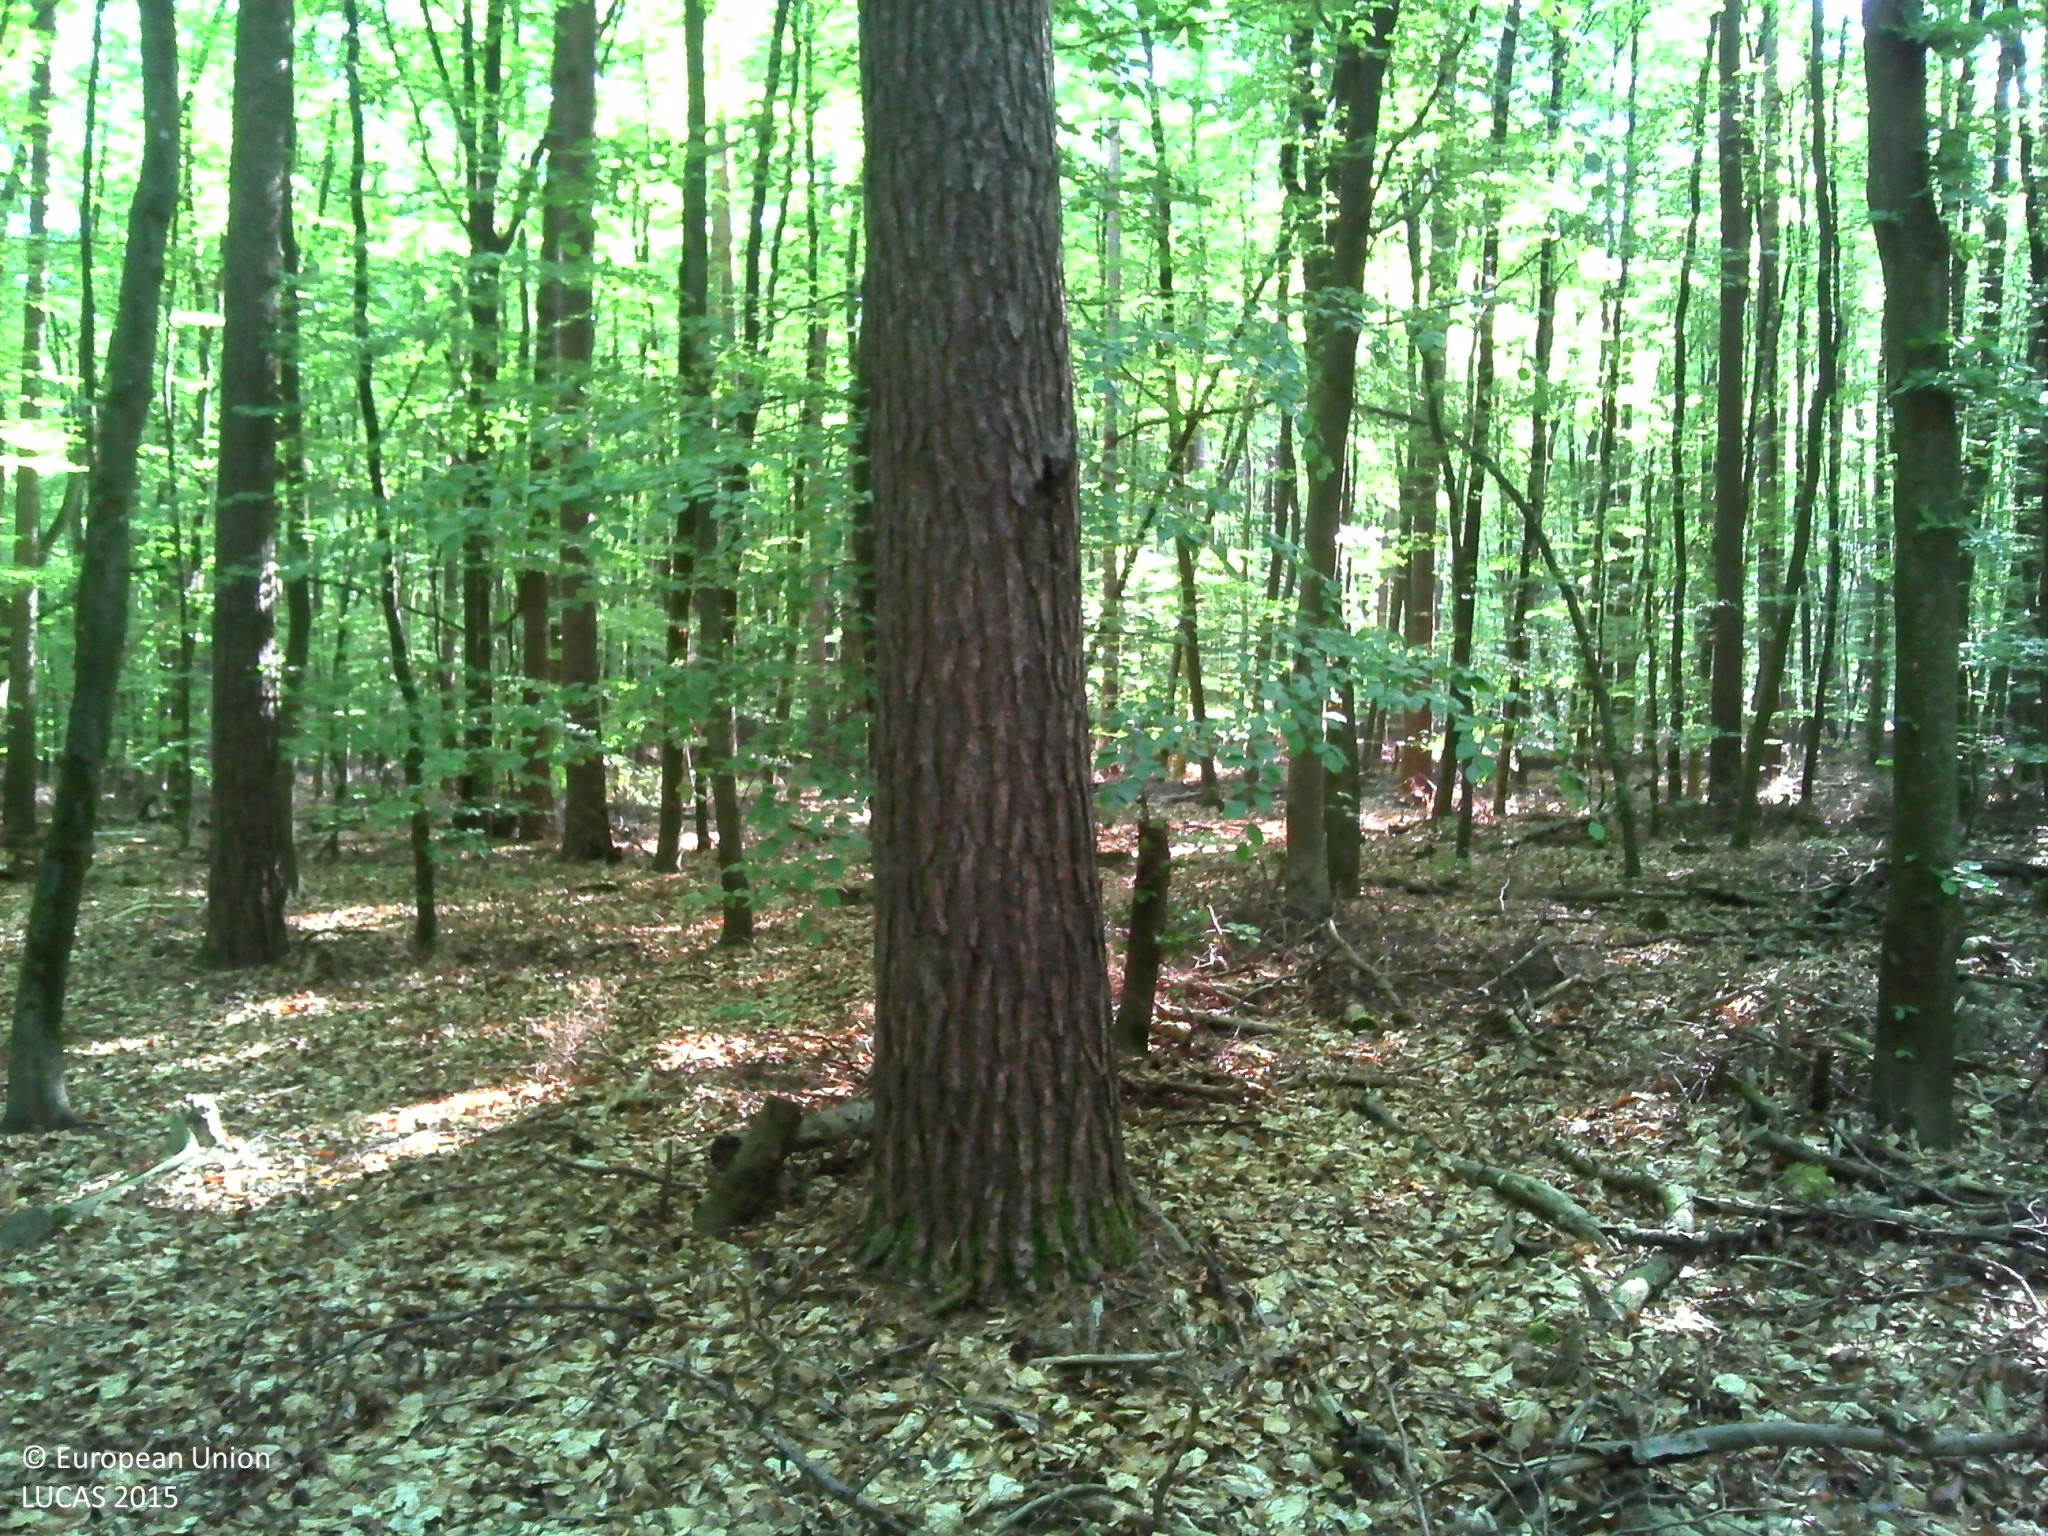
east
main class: Woodland
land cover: Broadleaved woodland
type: beech forest
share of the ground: > 75 %
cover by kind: broadleaved forest trees 95 %, coniferous forest trees 5 %
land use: Forestry
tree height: > 5 m
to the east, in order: Broadleaved woodland; Grass margins; Broadleaved woodland
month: May
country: LU
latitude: 49.7855
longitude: 6.4024
